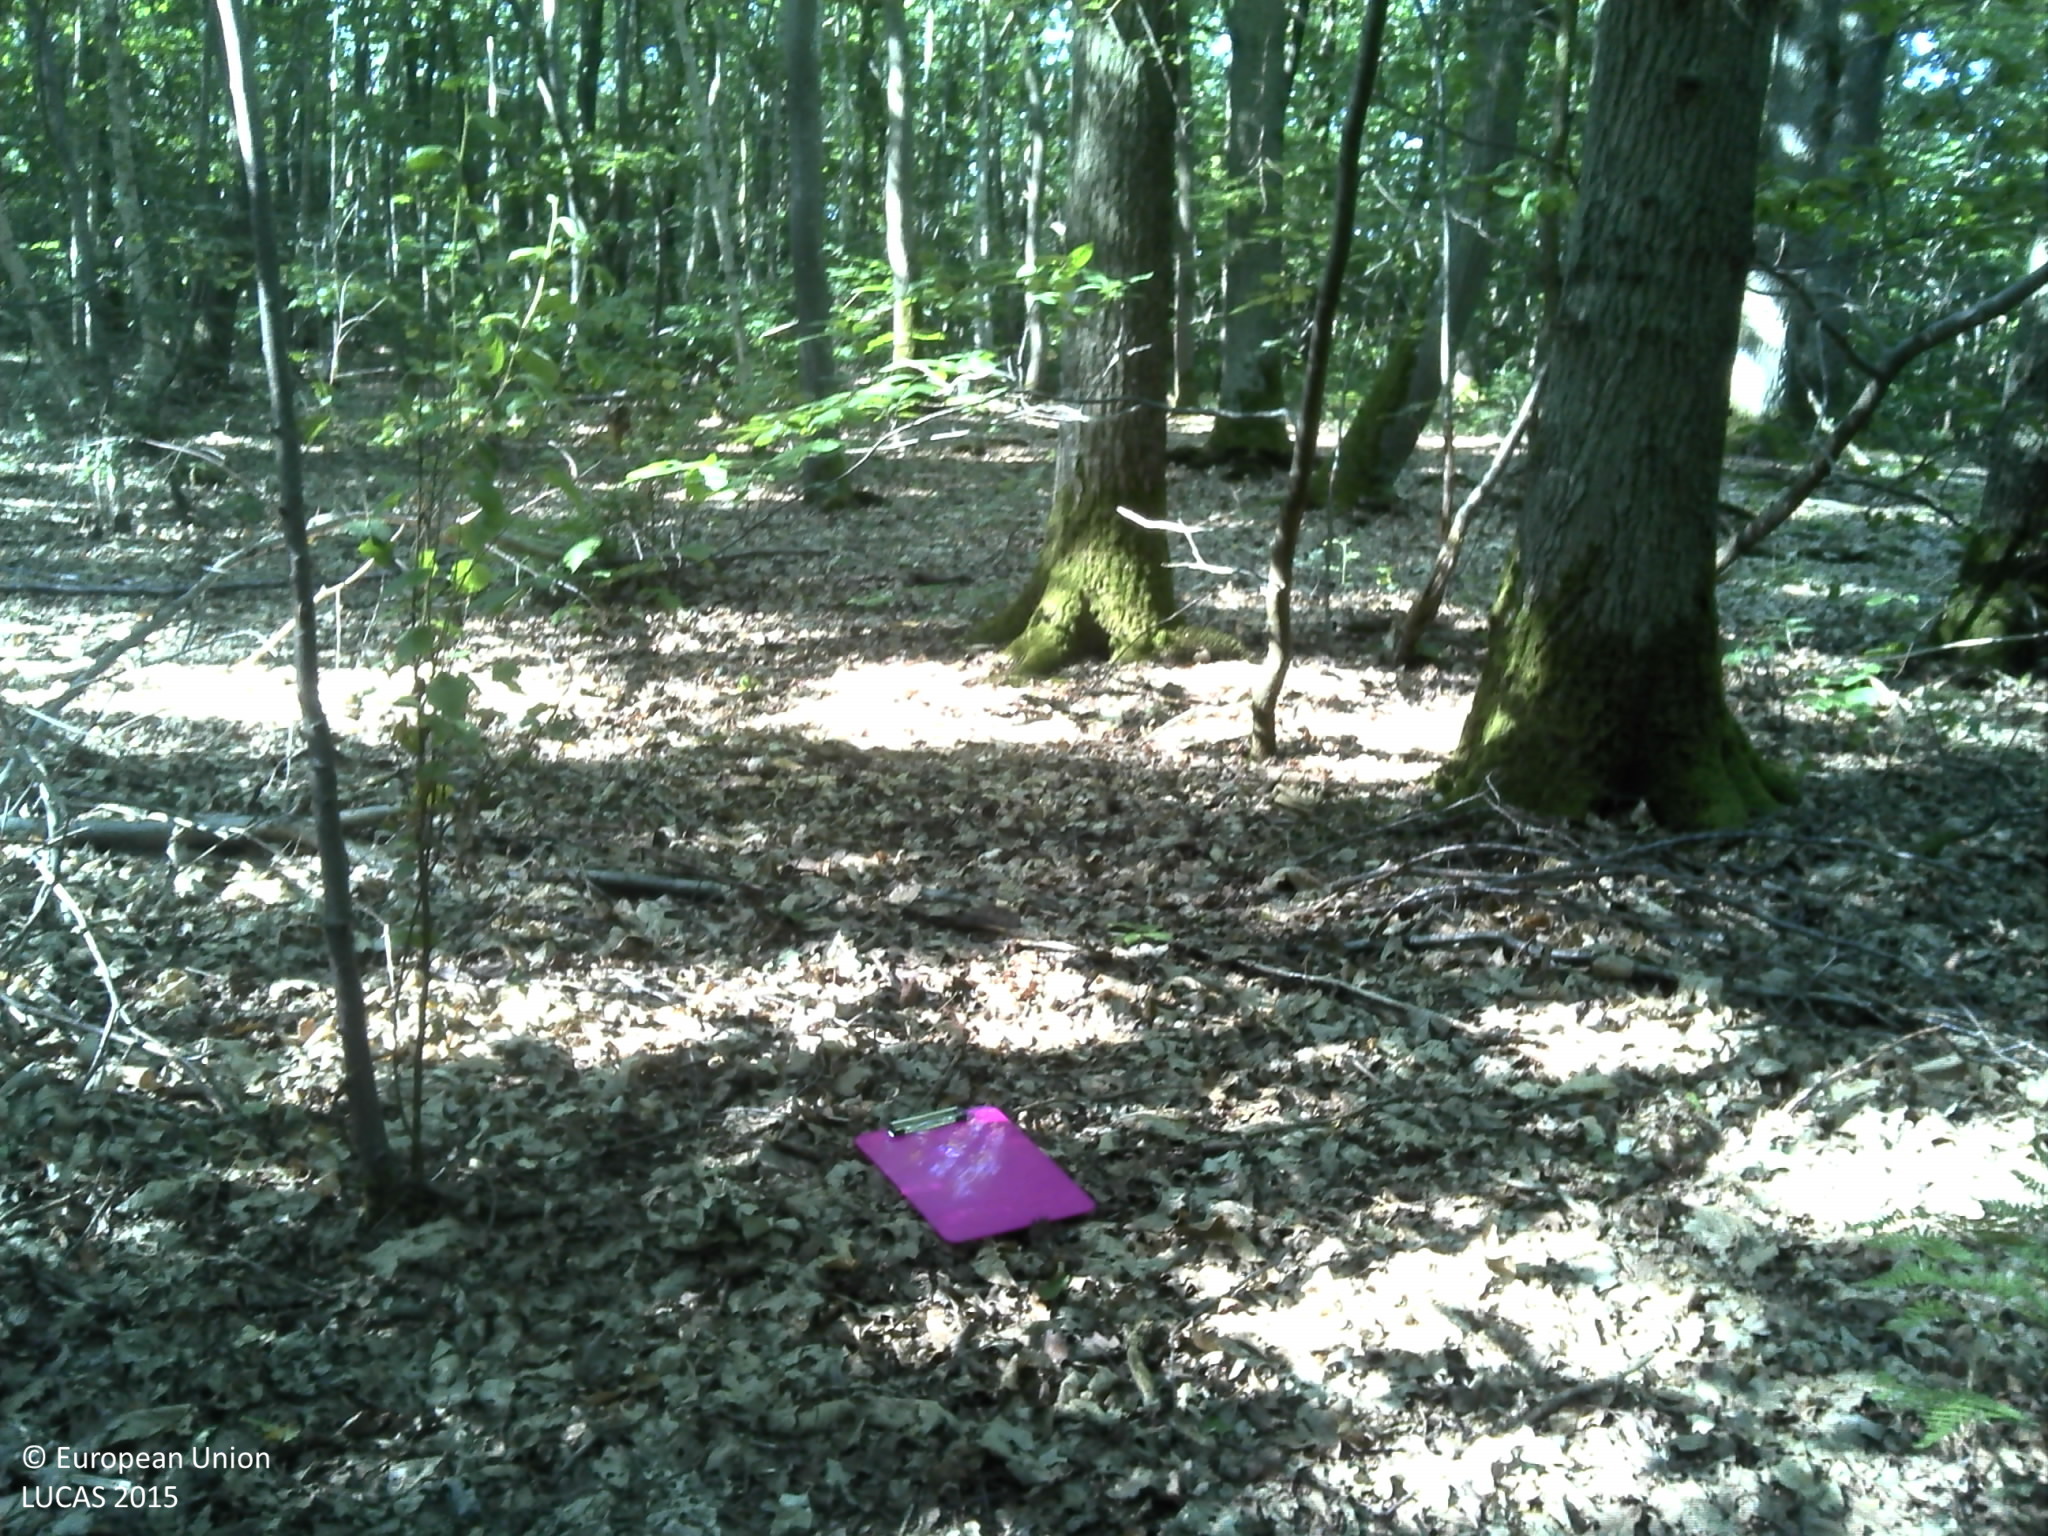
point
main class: Woodland
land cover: Broadleaved woodland
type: thermophilous deciduous forest
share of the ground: > 75 %
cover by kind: broadleaved forest trees 90 %, shrubs 10 %
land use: Forestry
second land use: Amenities, museums, leisure
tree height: > 5 m
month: August
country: FR
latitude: 48.7027
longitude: 1.9006
